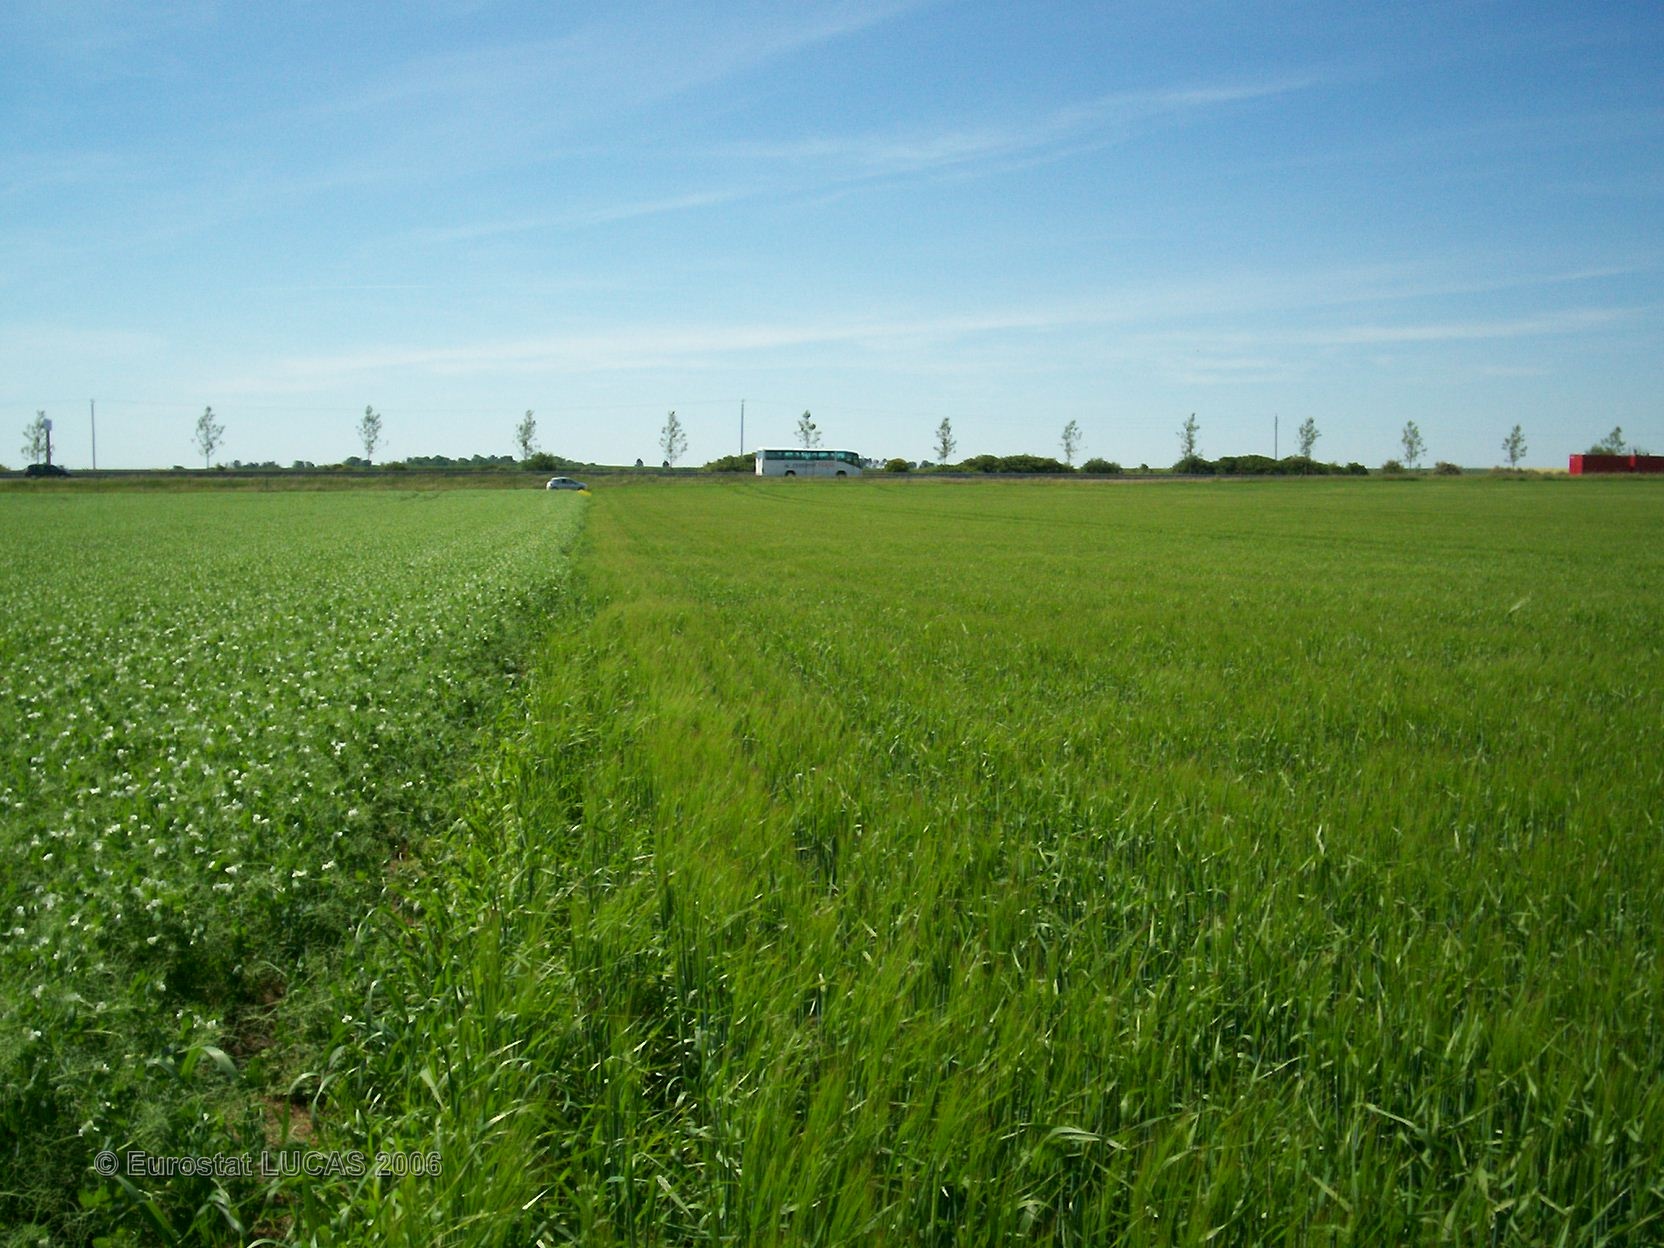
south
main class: Cropland
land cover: Barley
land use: Agriculture (excluding fallow land and kitchen gardens)
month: June
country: FR
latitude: 49.0736
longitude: 4.7818
